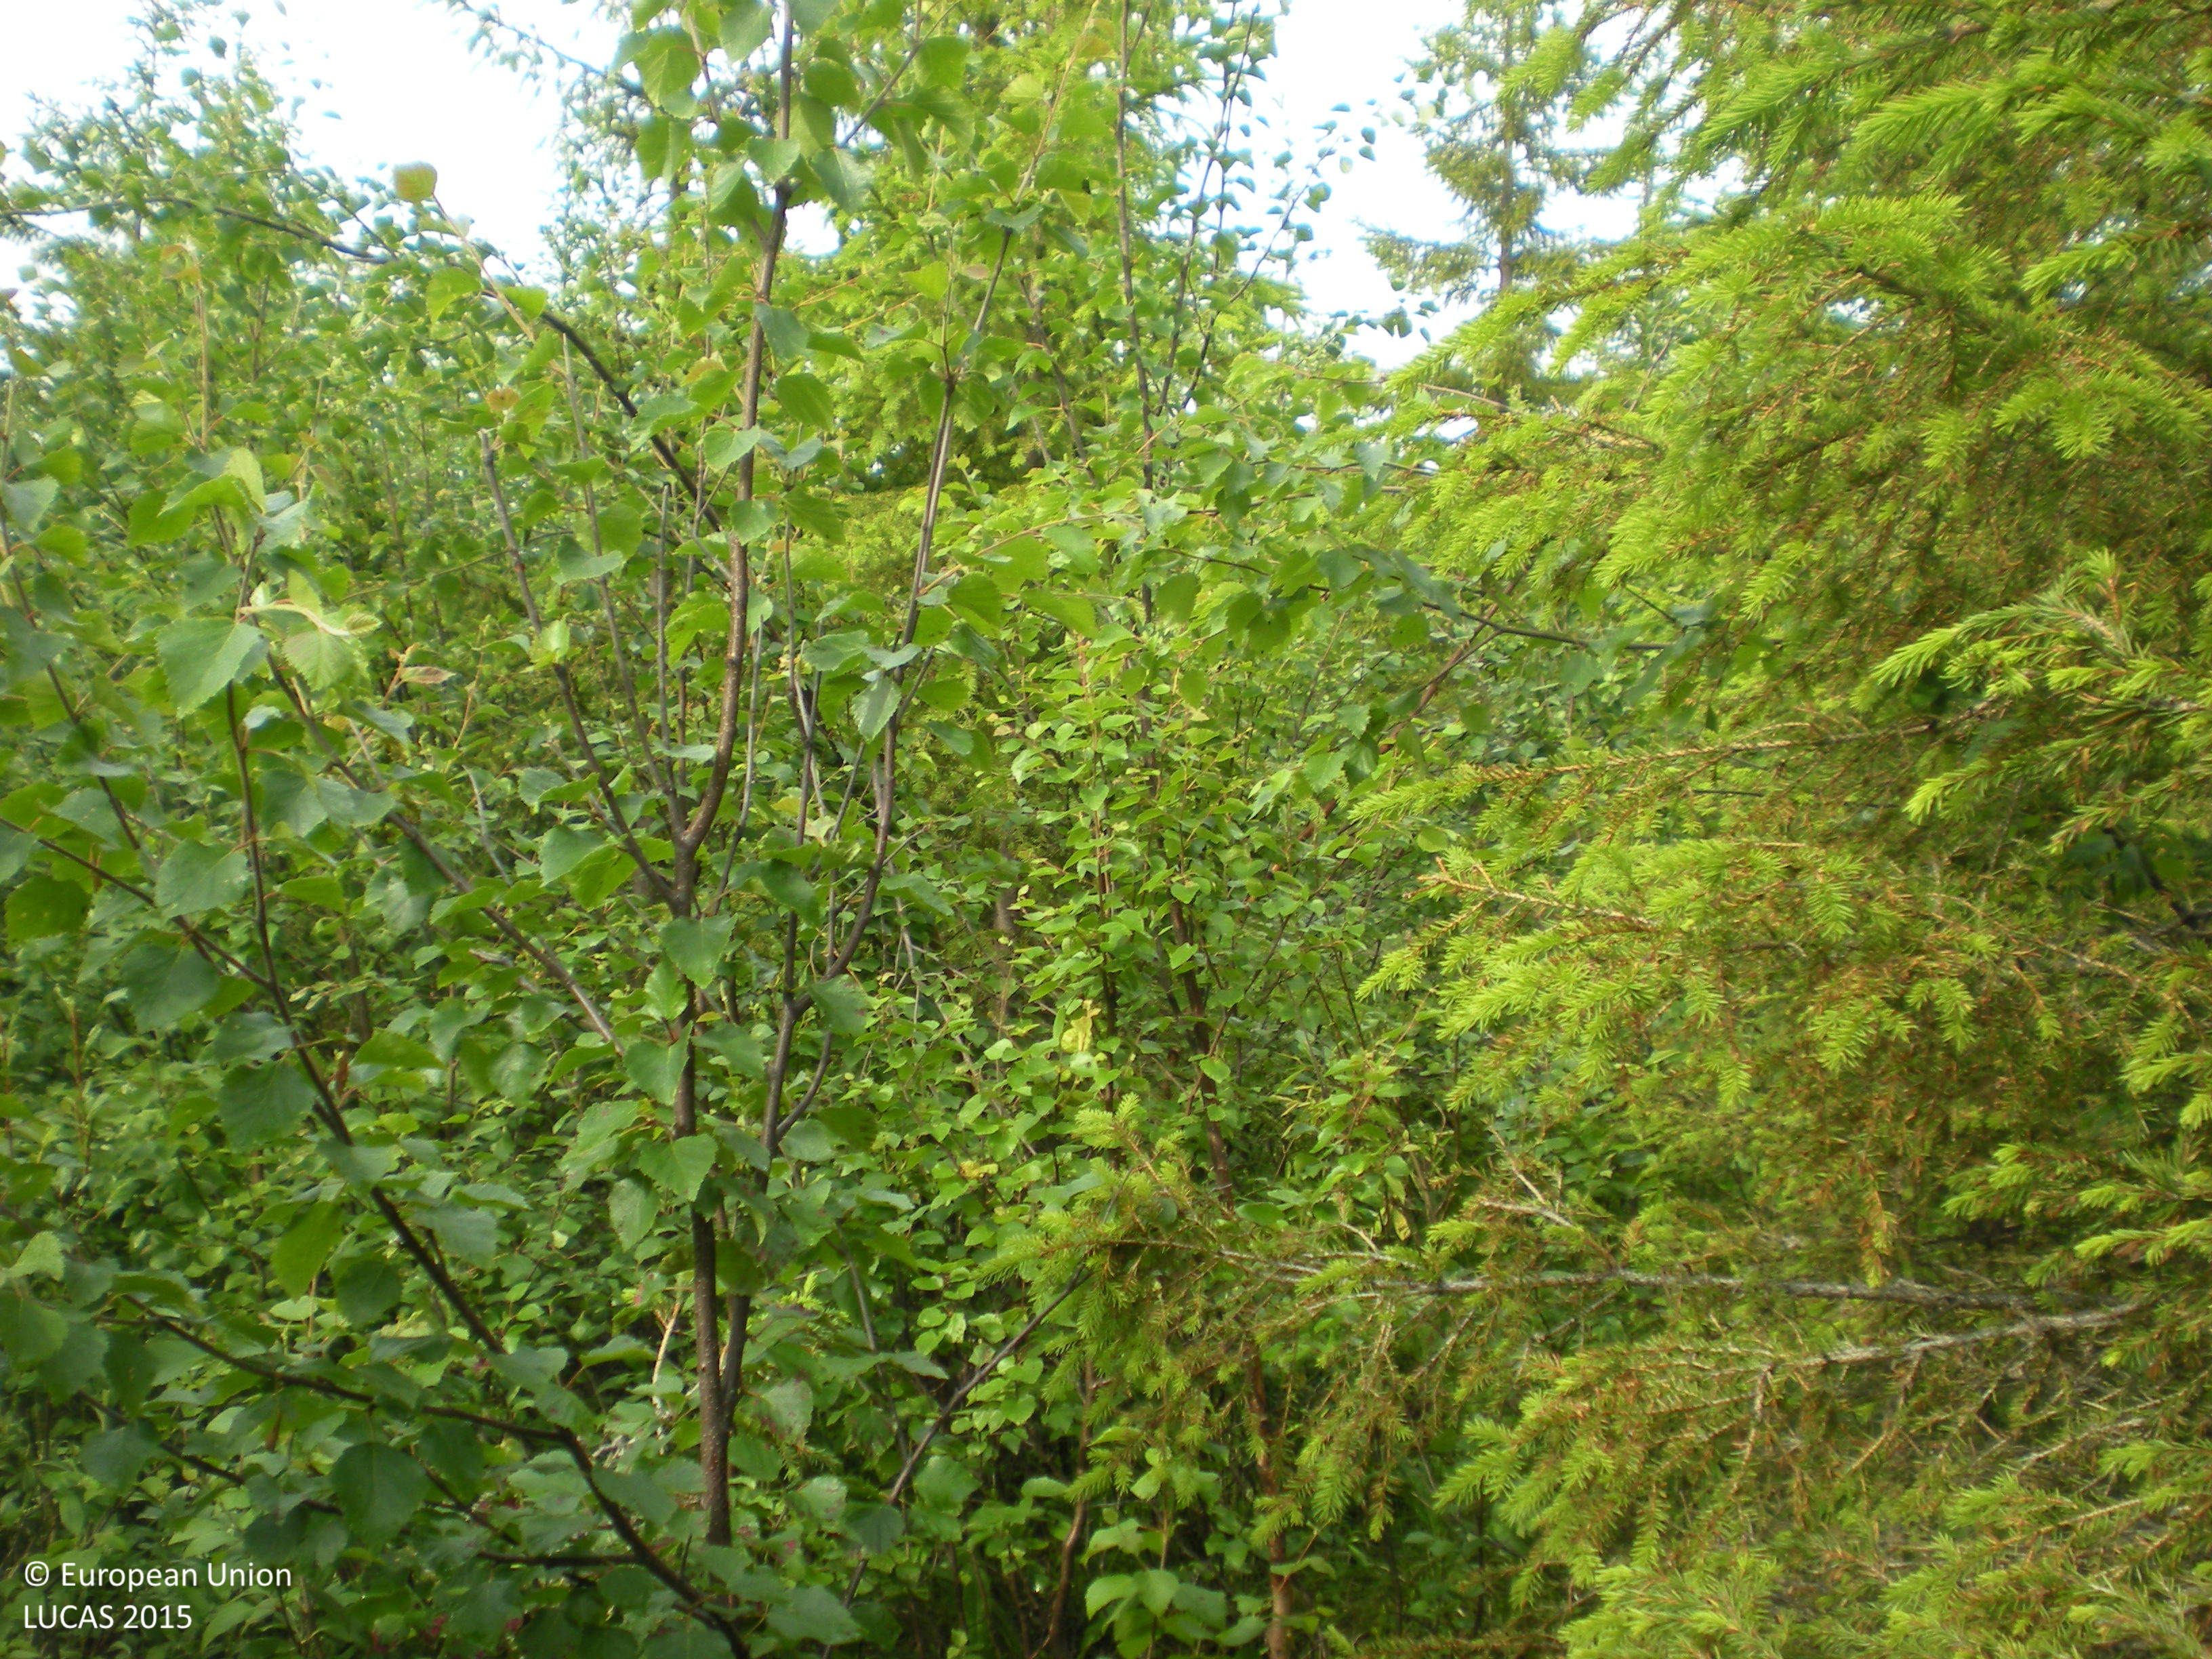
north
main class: Woodland
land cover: Spruce dominated mixed woodland
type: boreal forest
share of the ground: > 75 %
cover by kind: coniferous forest trees 45 %, broadleaved forest trees 40 %, herbaceous plants 10 %, shrubs 5 %
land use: Forestry
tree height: < 5 m
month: July
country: SE
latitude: 65.9598
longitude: 17.1943
